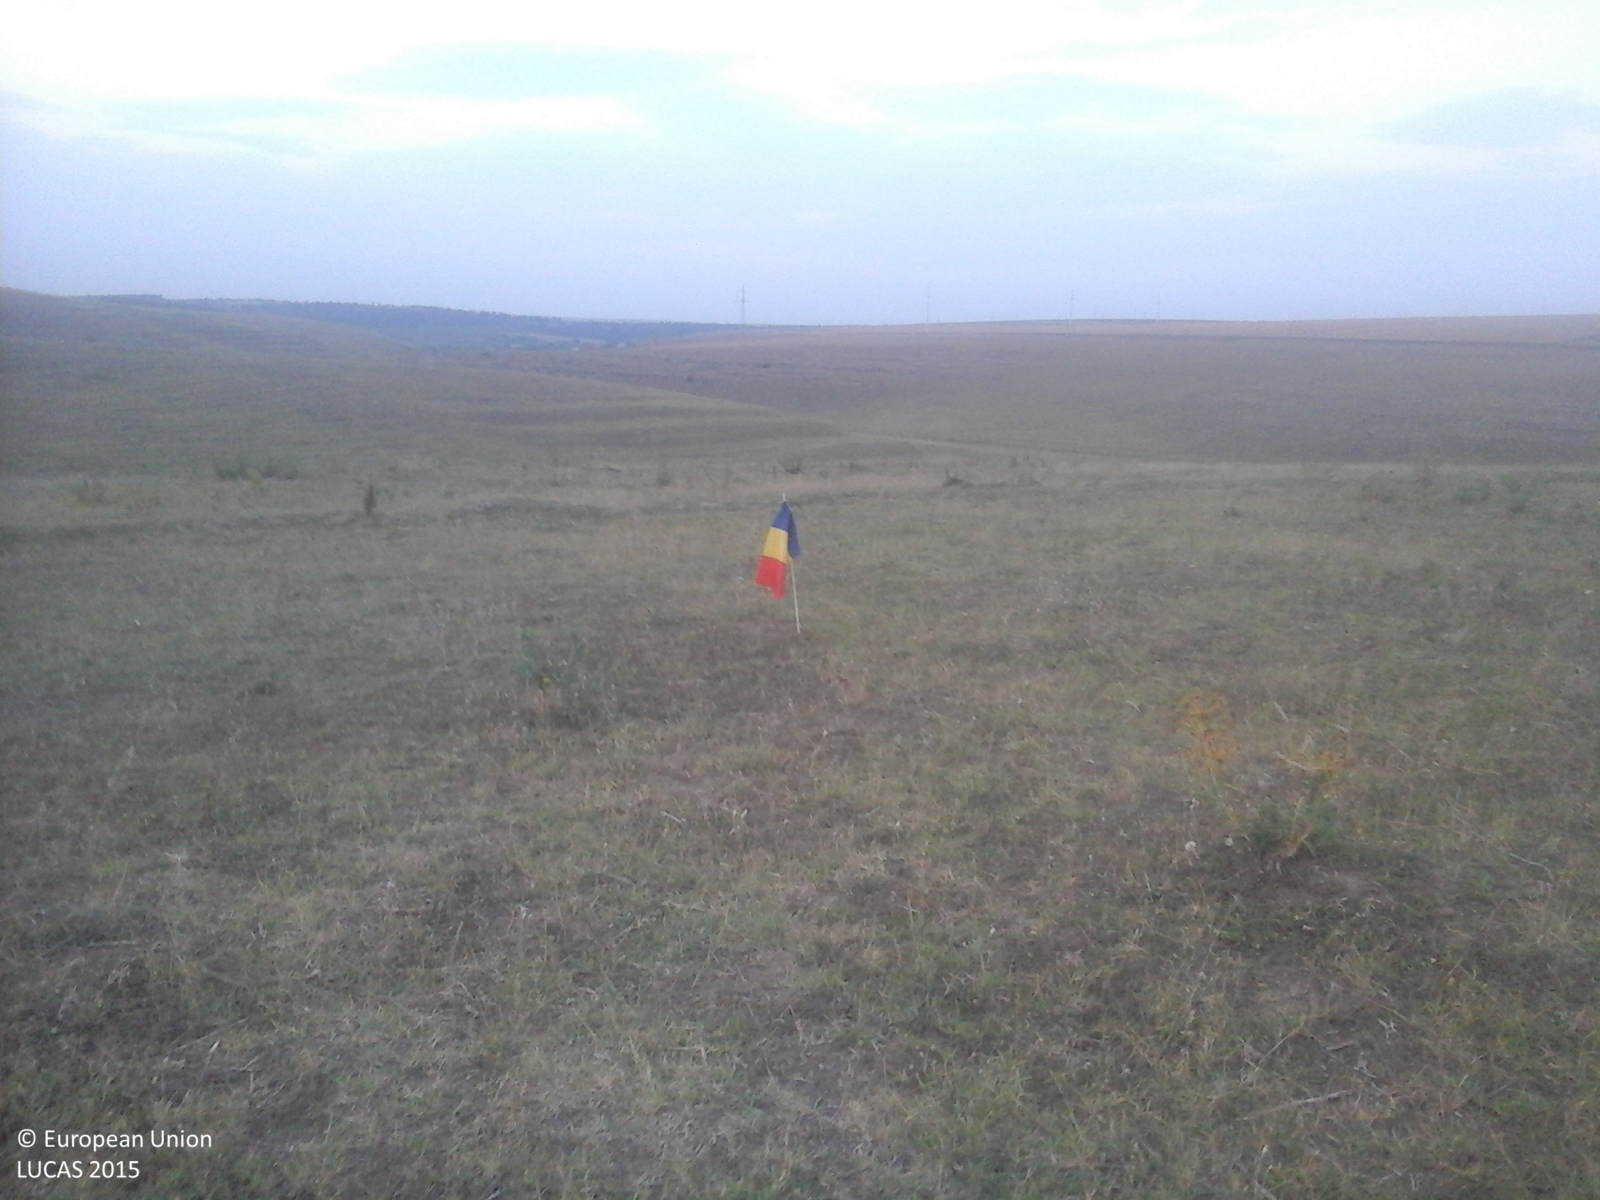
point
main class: Grassland
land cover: Grassland without tree/shrub cover
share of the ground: > 75 %
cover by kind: herbaceous plants 100 %
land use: Agriculture (excluding fallow land and kitchen gardens)
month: August
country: RO
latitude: 44.1584
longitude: 28.1262
